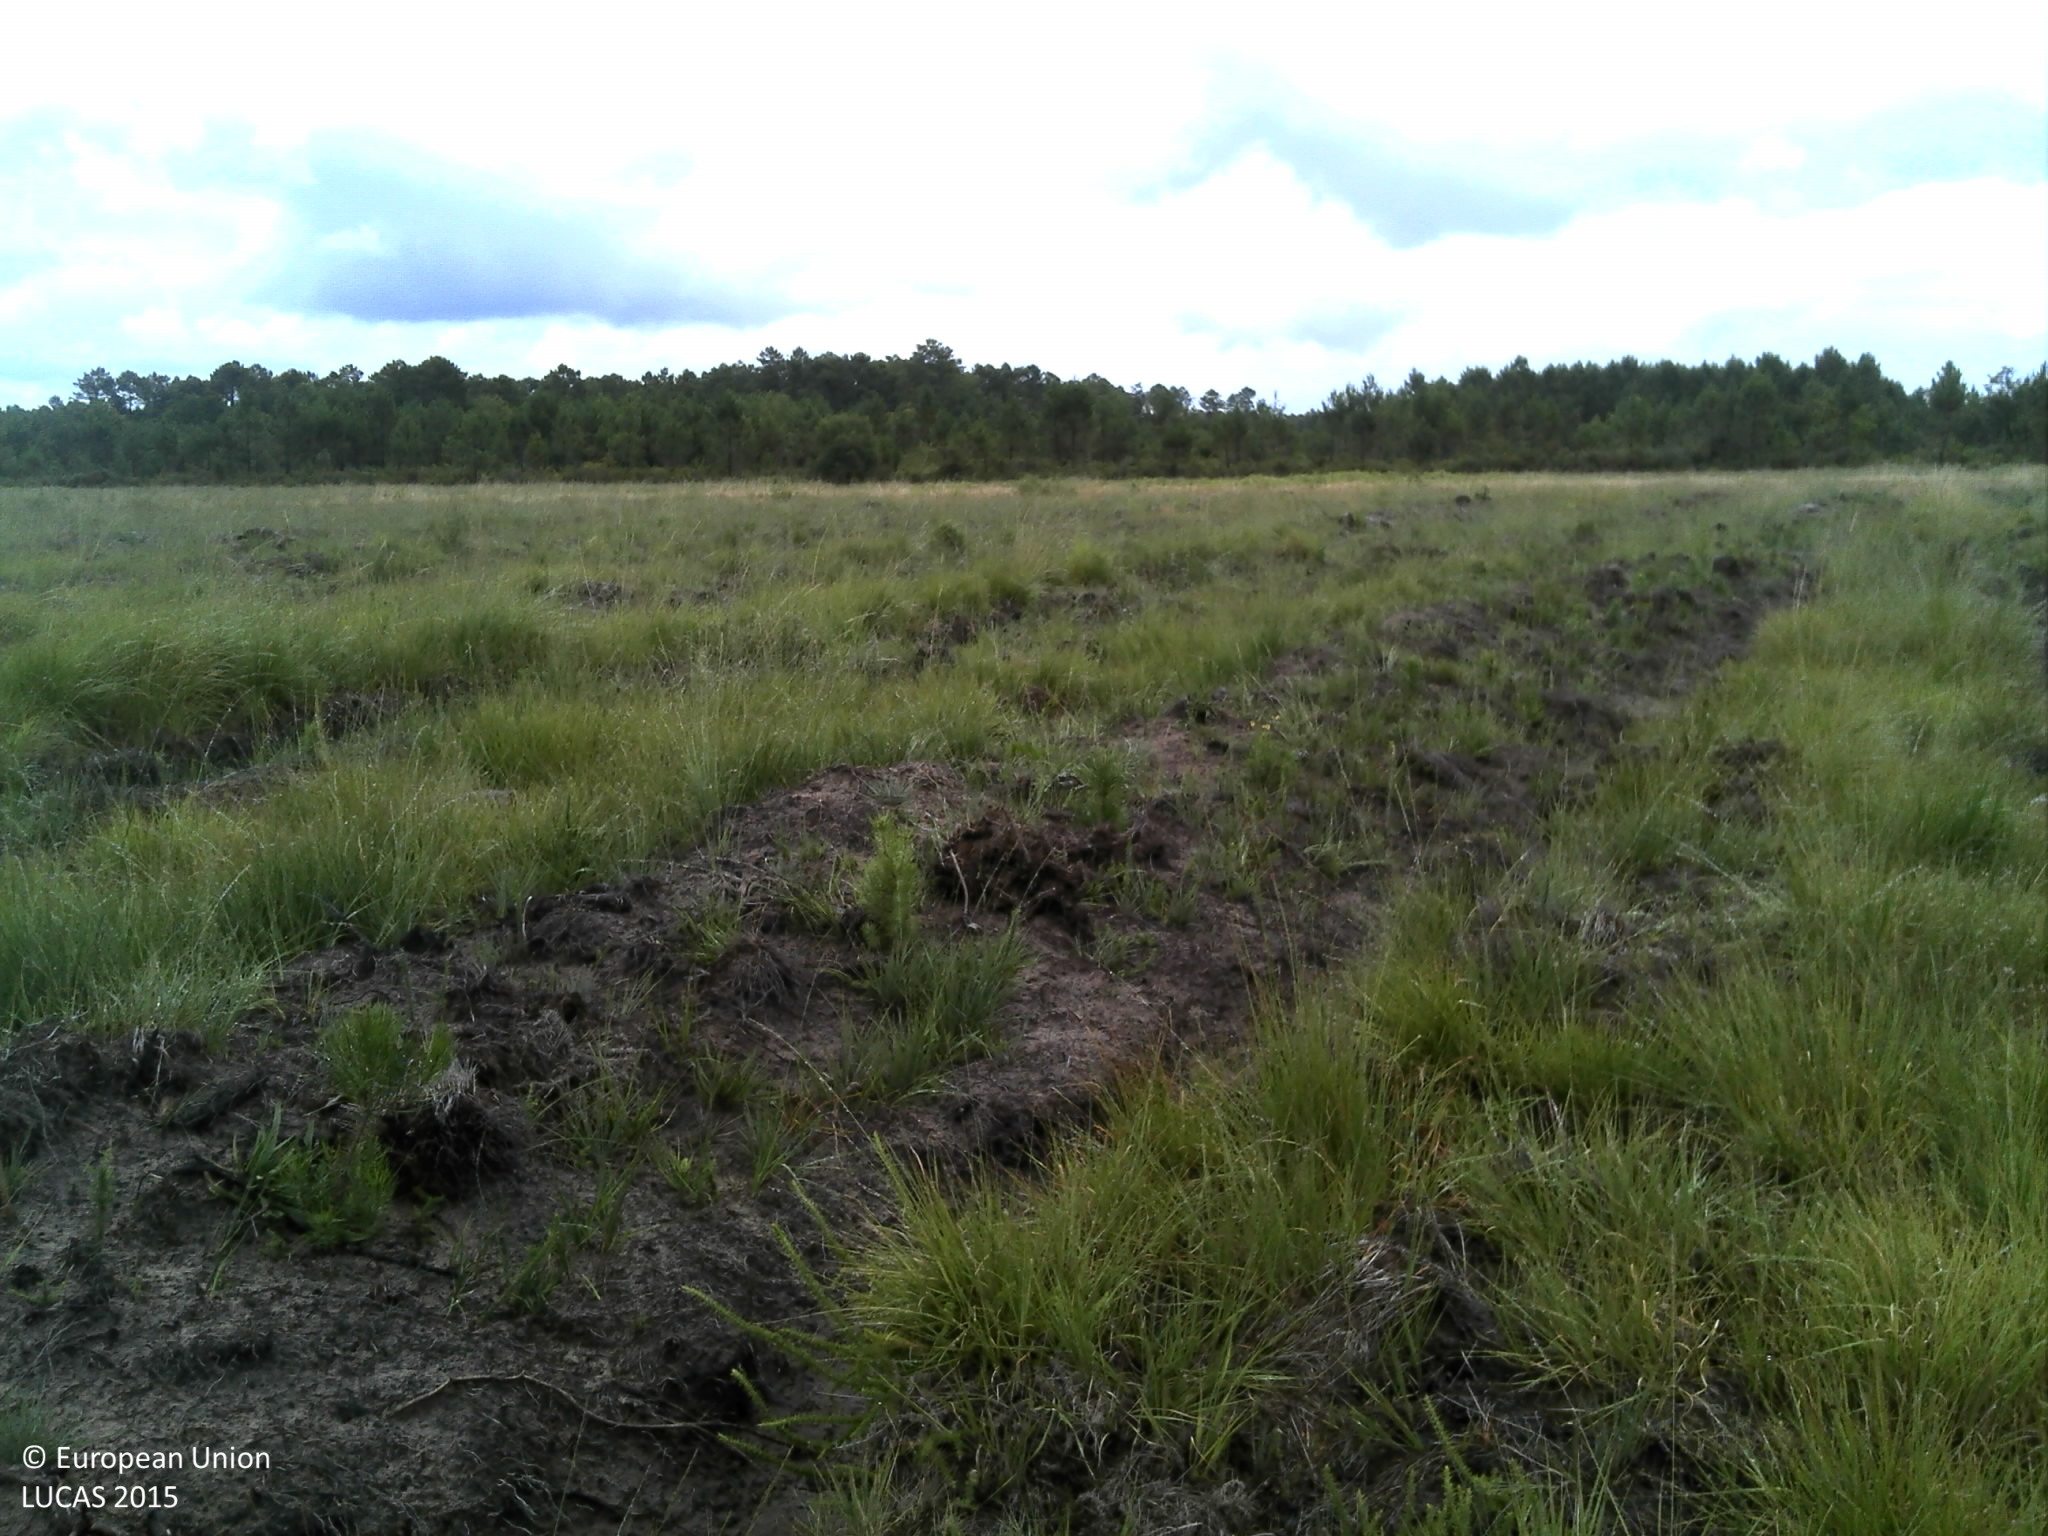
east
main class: Grassland
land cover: Spontaneously vegetated surfaces
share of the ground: > 75 %
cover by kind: herbaceous plants 95 %, shrubs 5 %
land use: Forestry
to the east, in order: Spontaneously vegetated surfaces; Ditches and canals; Spontaneously vegetated surfaces; Shrubland with sparse tree cover; Pine dominated mixed woodland
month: August
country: FR
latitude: 44.5859
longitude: -0.9662
